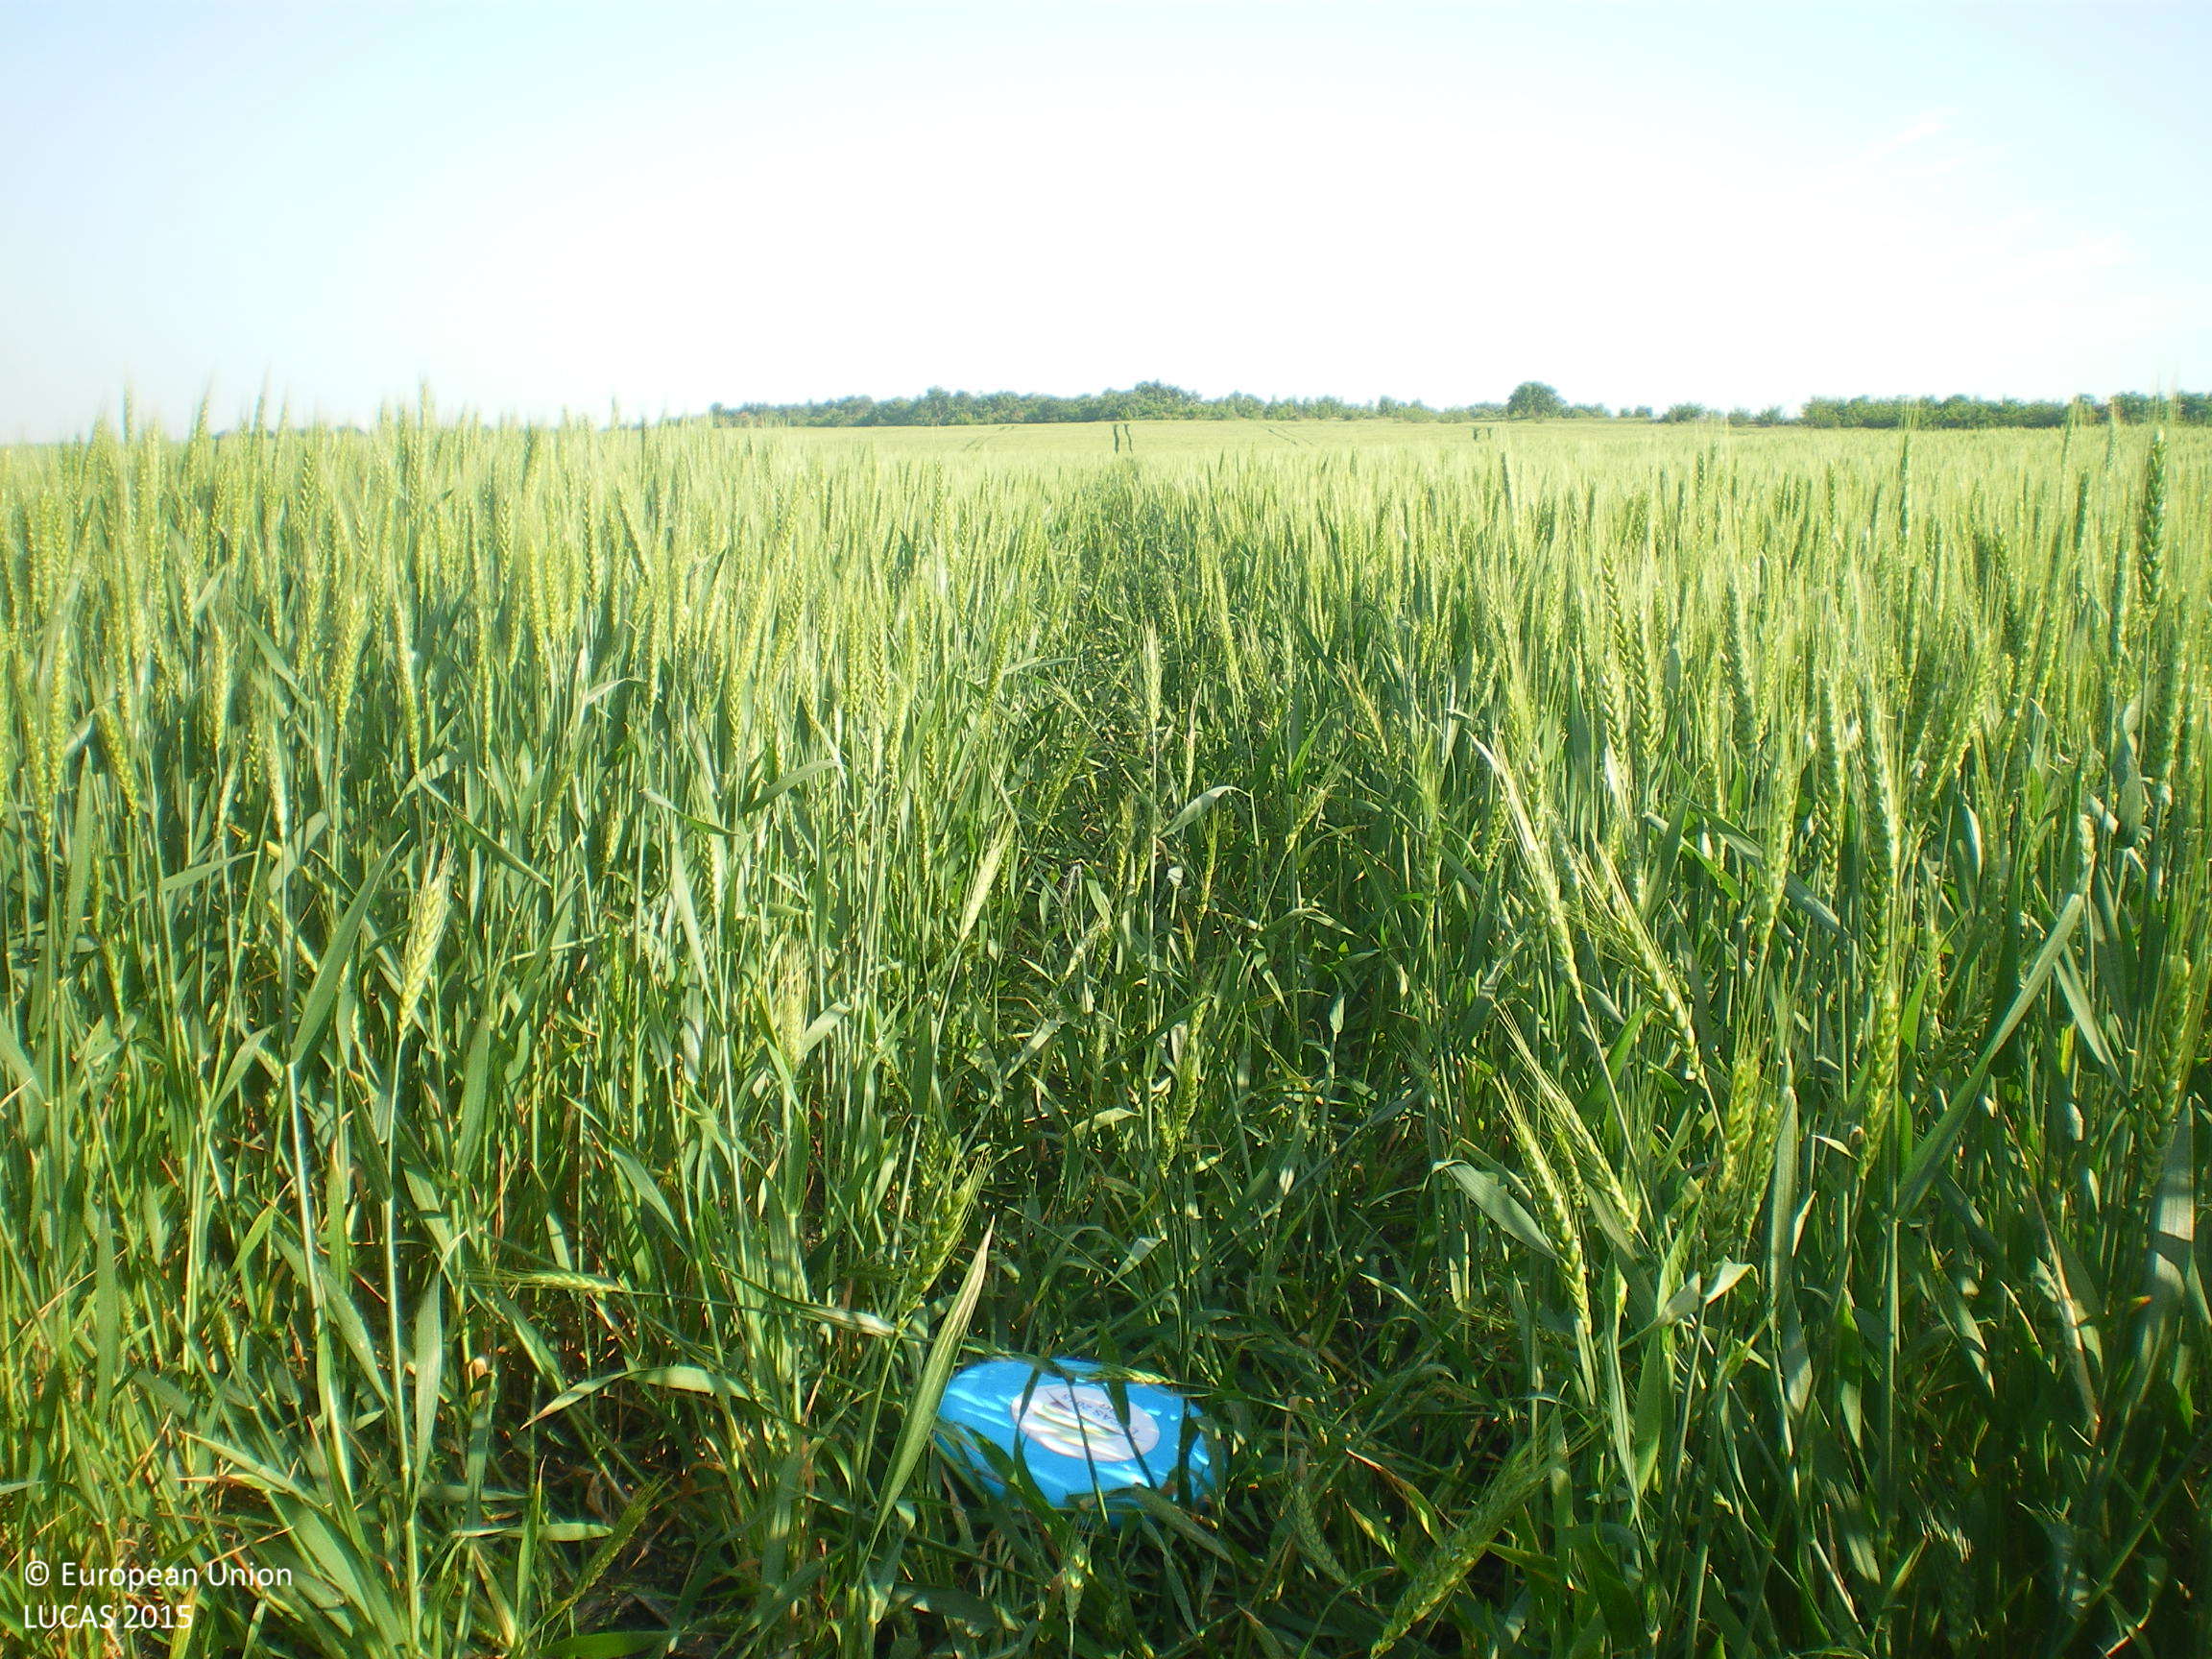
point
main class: Cropland
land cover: Barley
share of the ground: > 75 %
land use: Agriculture (excluding fallow land and kitchen gardens)
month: May
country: BG
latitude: 42.1441
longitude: 25.4192
